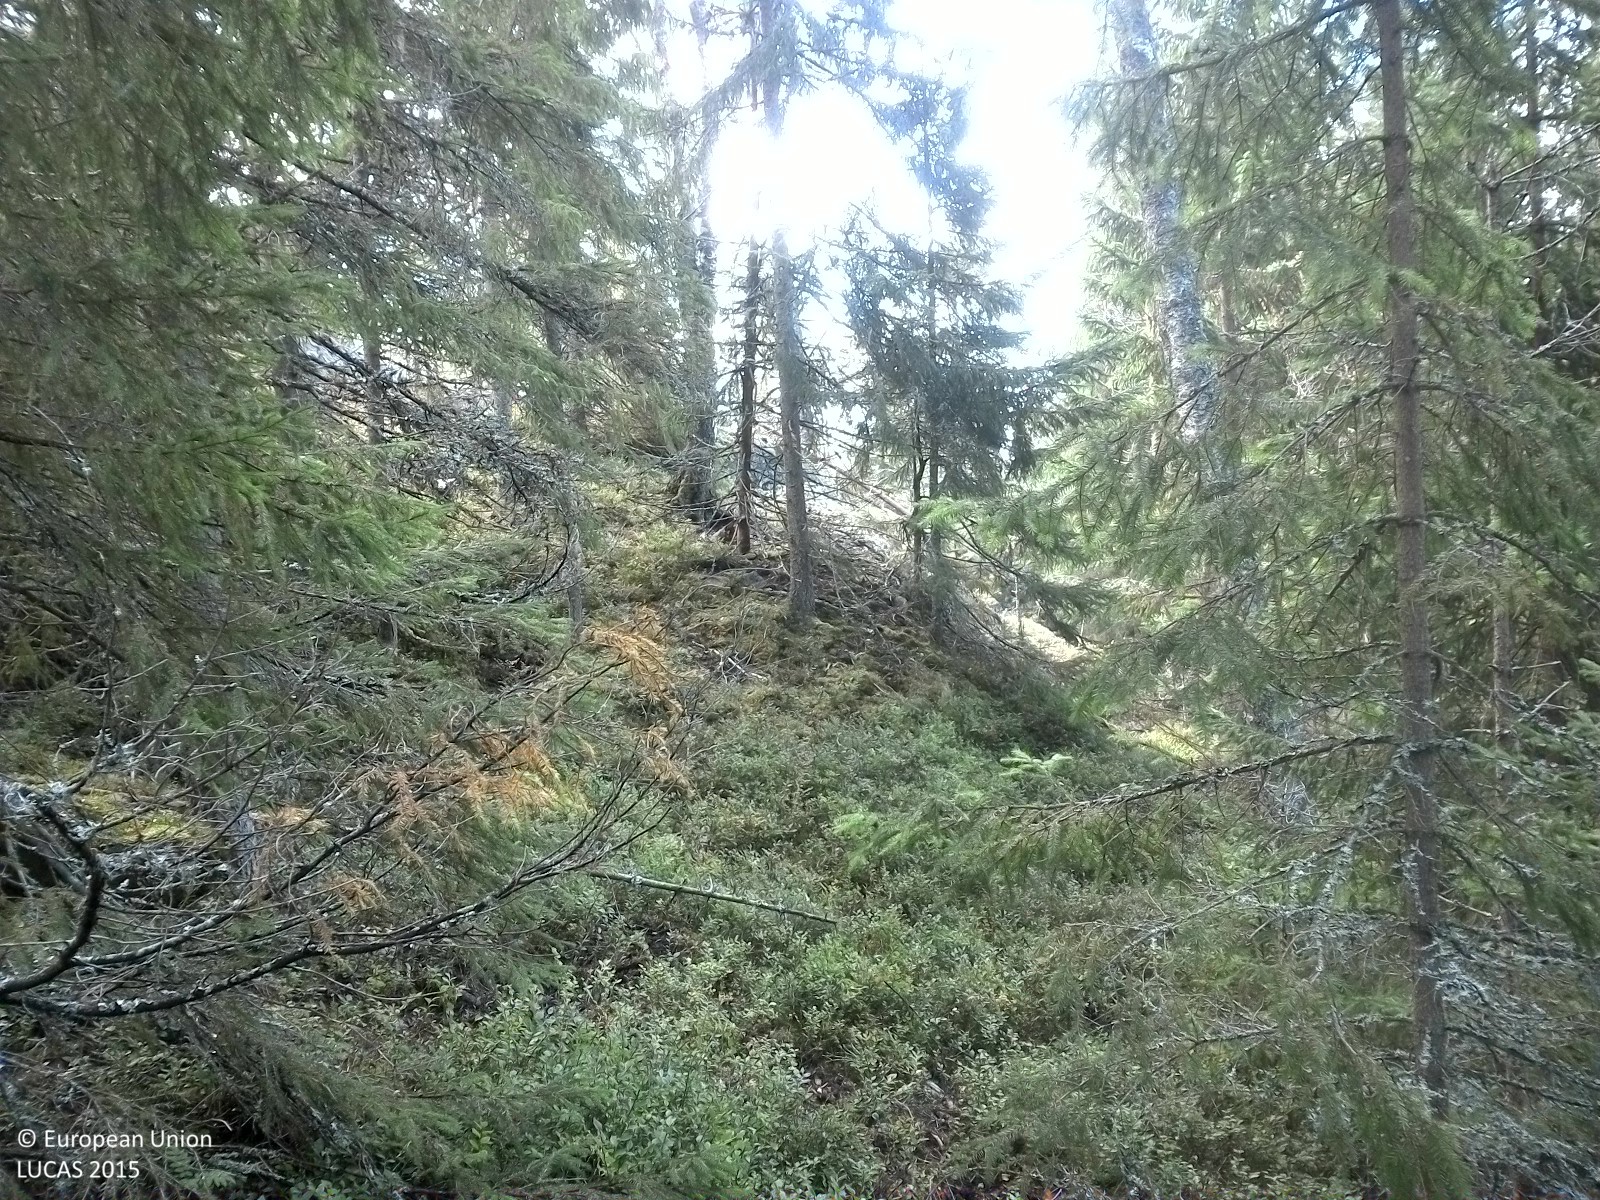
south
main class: Woodland
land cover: Pine dominated mixed woodland
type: boreal forest
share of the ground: 25 - 50 %
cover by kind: herbaceous plants 65 %, coniferous forest trees 20 %, broadleaved forest trees 10 %, lichens and mosses 5 %
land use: Forestry
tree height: > 5 m
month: August
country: SE
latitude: 58.9739
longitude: 15.4719
